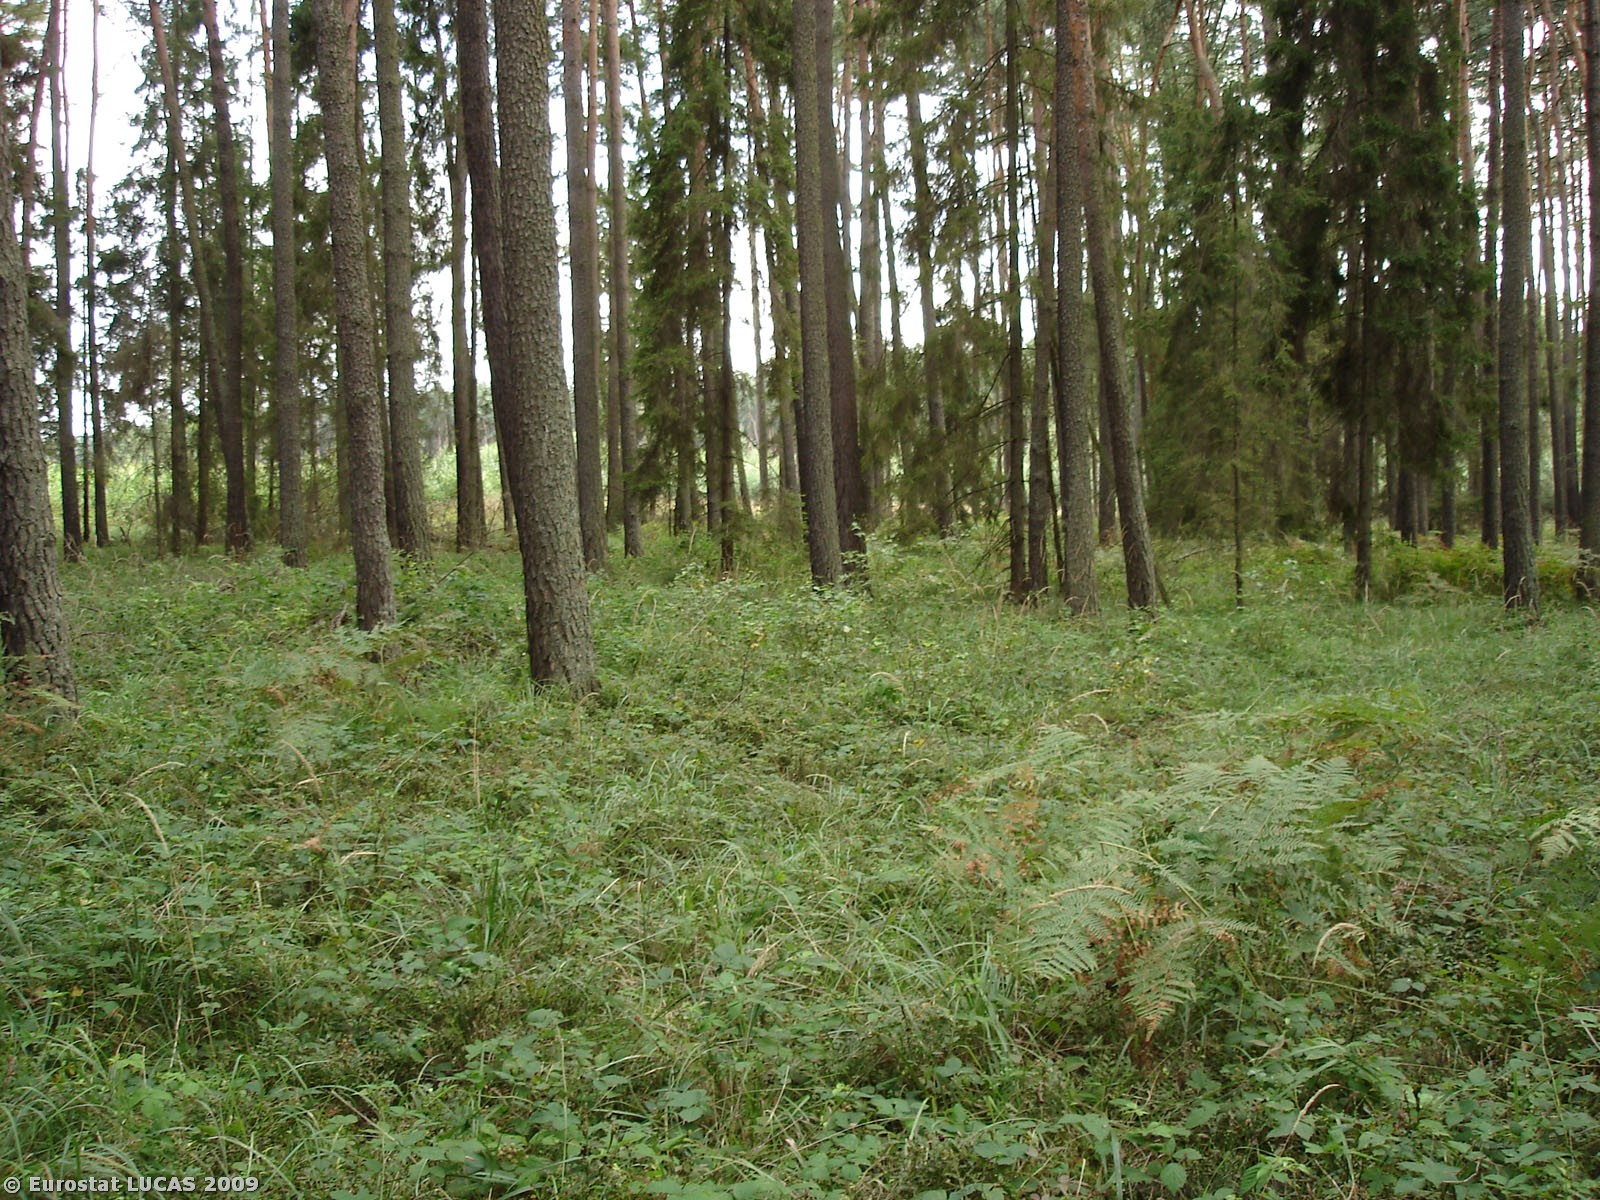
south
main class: Woodland
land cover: Coniferous woodland
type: hemiboreal forest and nemoral coniferous forest and mixed broadleaved-coniferous forest
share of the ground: > 75 %
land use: Forestry
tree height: > 5 m
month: August
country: PL
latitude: 50.7881
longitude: 18.2591
